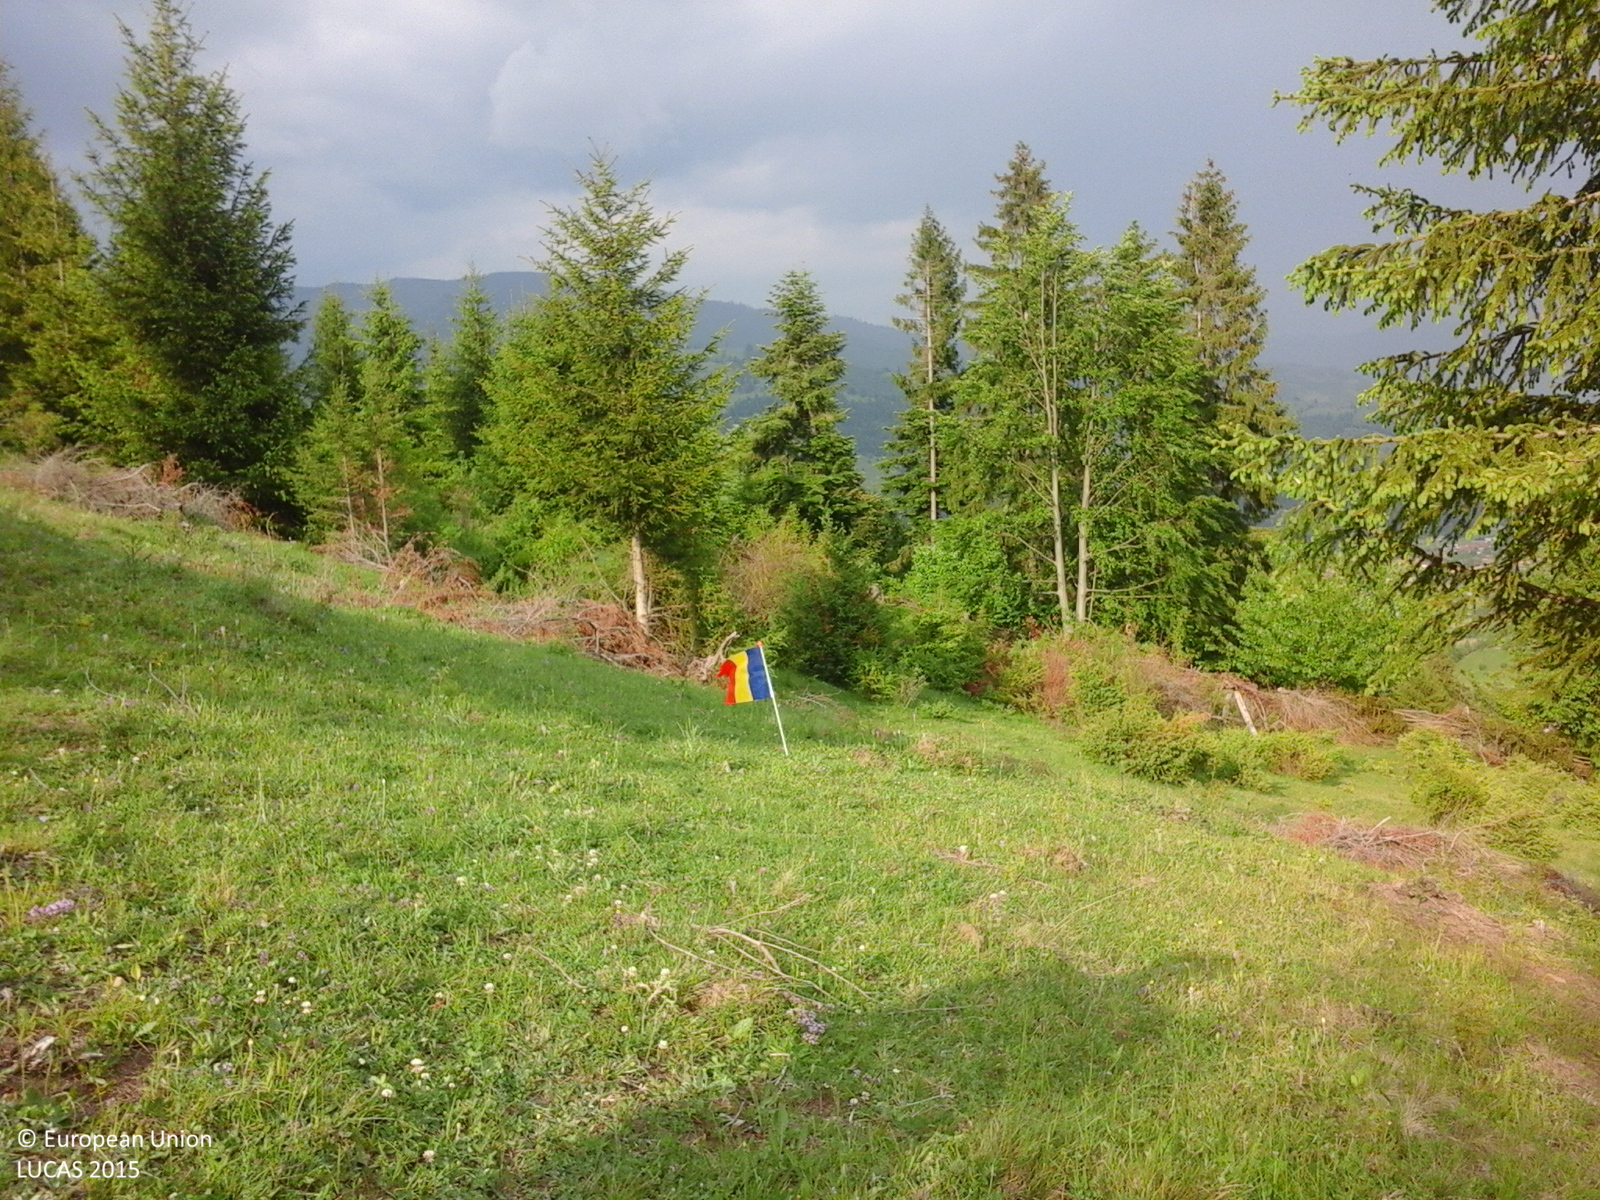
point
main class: Grassland
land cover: Grassland with sparse tree/shrub cover
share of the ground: > 75 %
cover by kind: herbaceous plants 95 %, coniferous forest trees 5 %
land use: Agriculture (excluding fallow land and kitchen gardens)
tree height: < 5 m
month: June
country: RO
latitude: 46.5350
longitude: 26.0961
